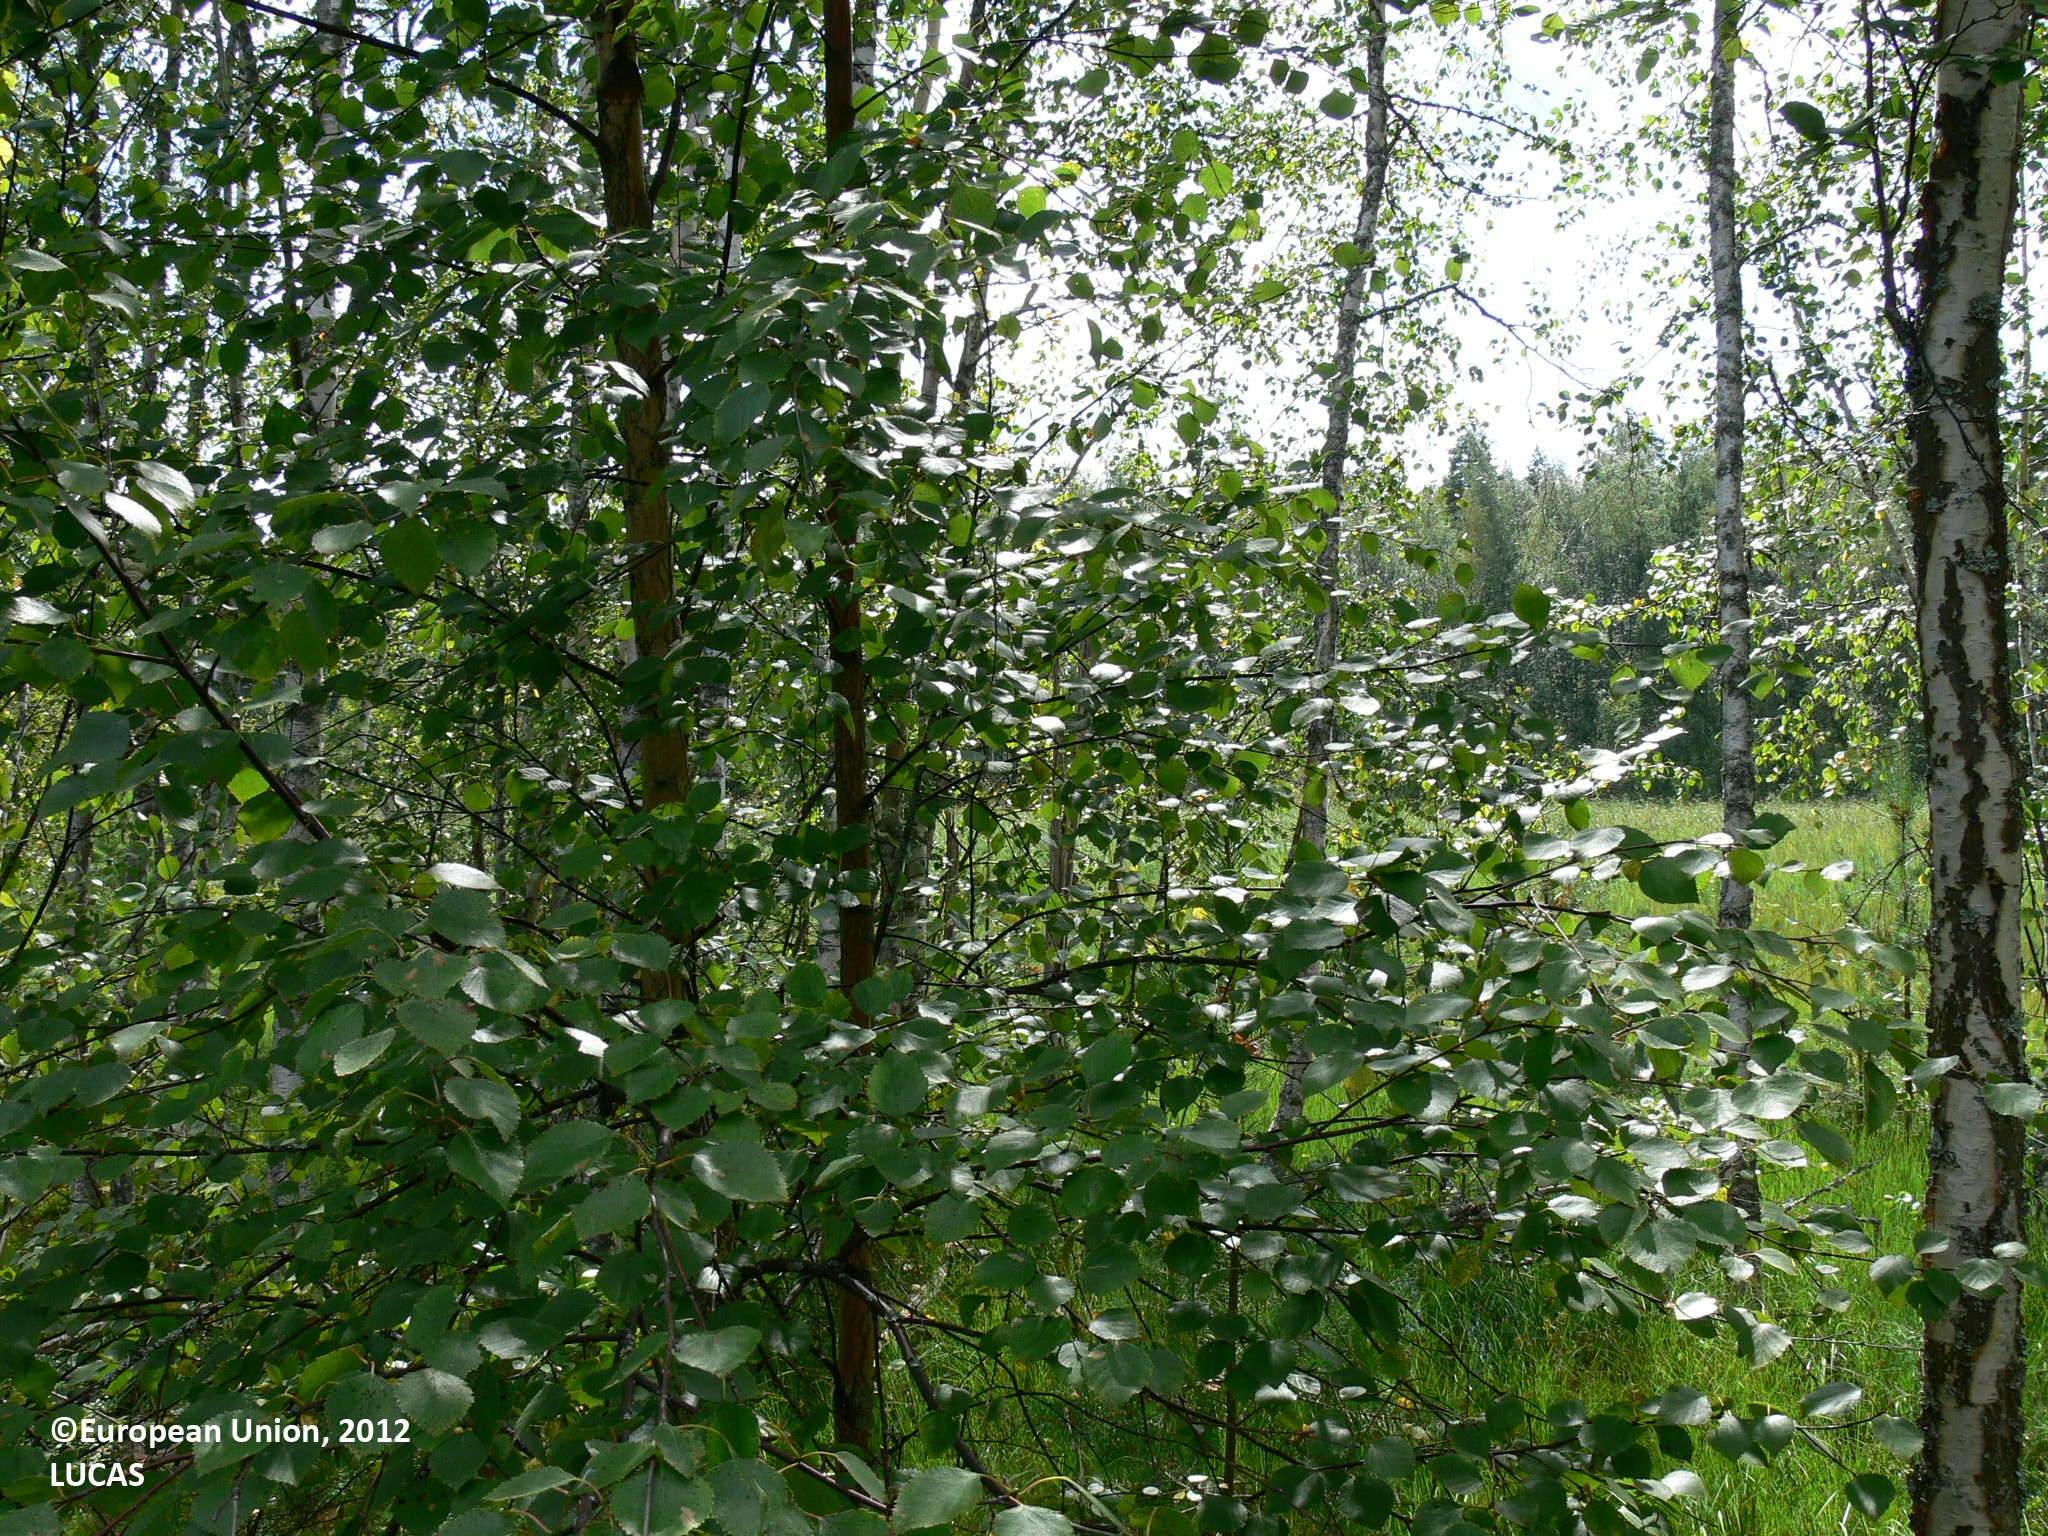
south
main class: Woodland
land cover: Broadleaved woodland
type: boreal forest
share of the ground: 50 - 75 %
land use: Forestry
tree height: < 5 m
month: August
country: FI
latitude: 61.8871
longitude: 29.2800
